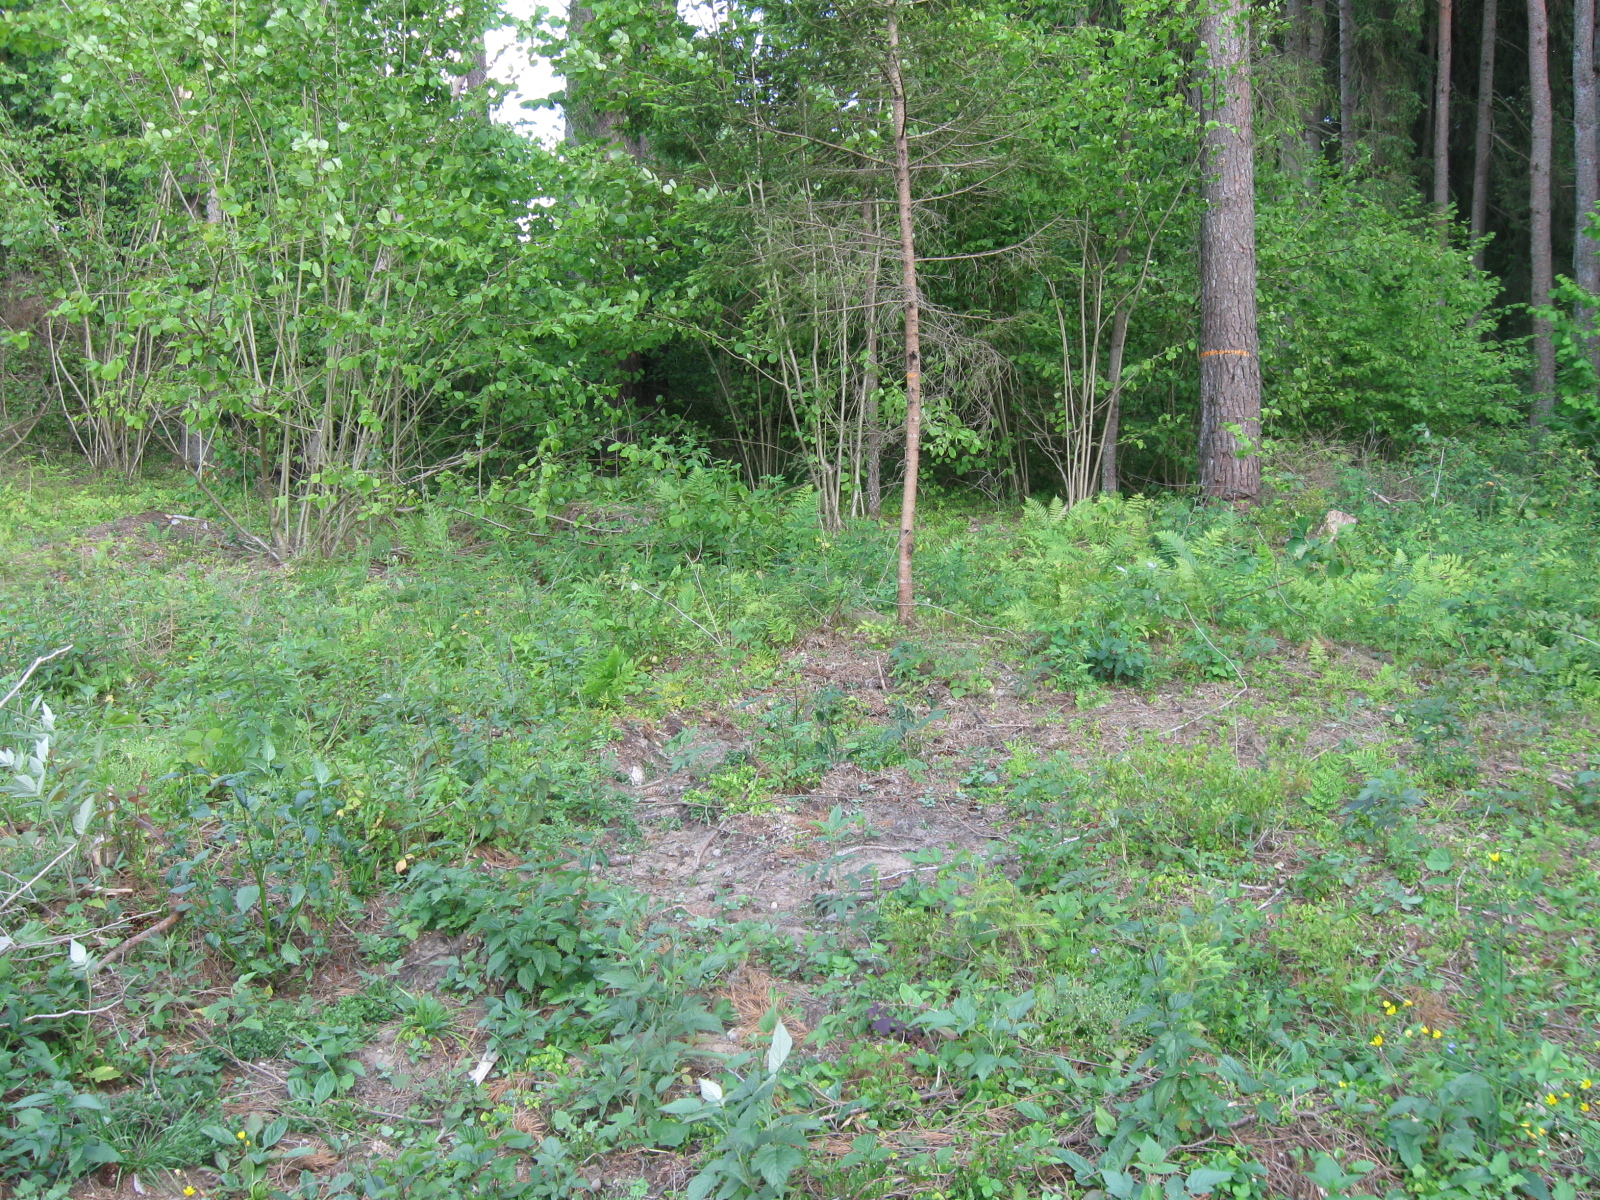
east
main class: Grassland
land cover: Spontaneously vegetated surfaces
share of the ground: > 75 %
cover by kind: herbaceous plants 75 %, unconsolidated bare surface 25 %
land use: Forestry
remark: Clear cut
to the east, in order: Spontaneously vegetated surfaces; Other mixed woodland
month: July
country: LT
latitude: 54.2266
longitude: 24.3189
